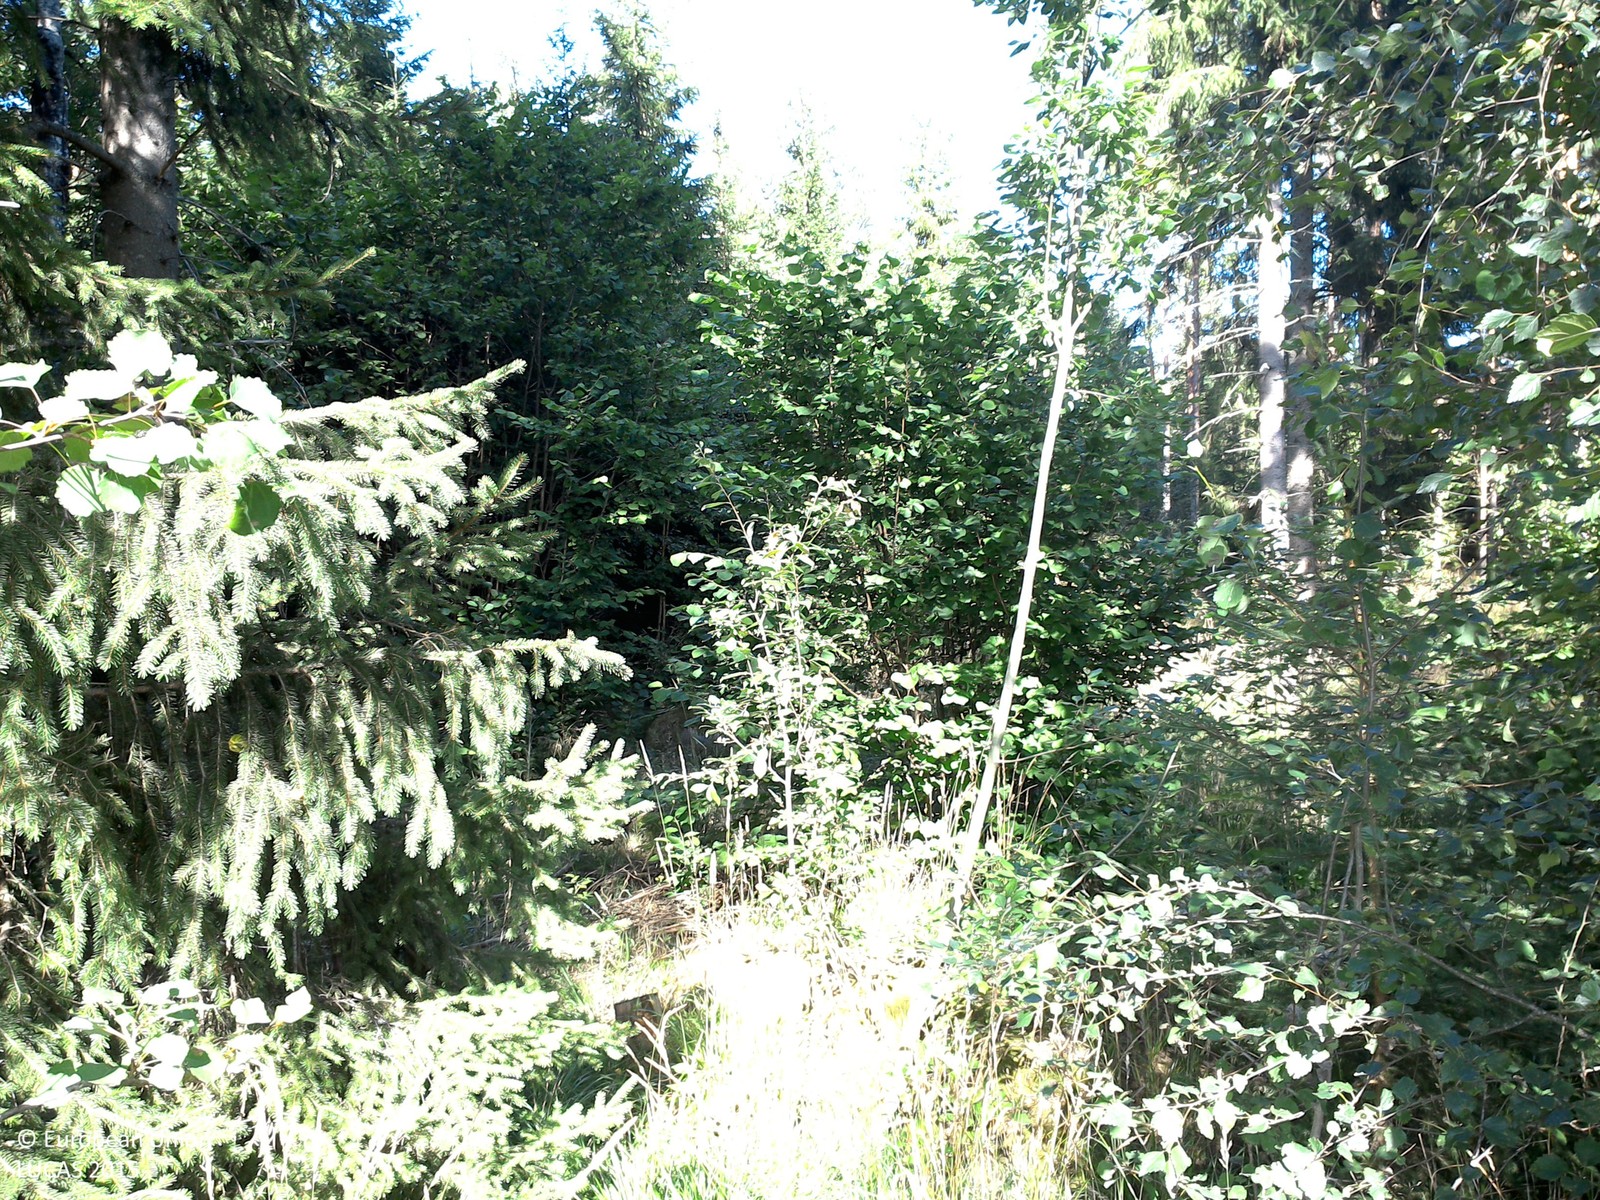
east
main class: Woodland
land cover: Broadleaved woodland
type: boreal forest
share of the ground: 50 - 75 %
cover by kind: broadleaved forest trees 55 %, herbaceous plants 40 %, coniferous forest trees 5 %
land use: Forestry
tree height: > 5 m
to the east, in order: Broadleaved woodland; Pine dominated coniferous woodland; Spruce dominated coniferous woodland; Pine dominated coniferous woodland; Paved roads, cycling and walking lanes; Pine dominated coniferous woodland
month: August
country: SE
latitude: 57.9604
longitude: 15.5560
